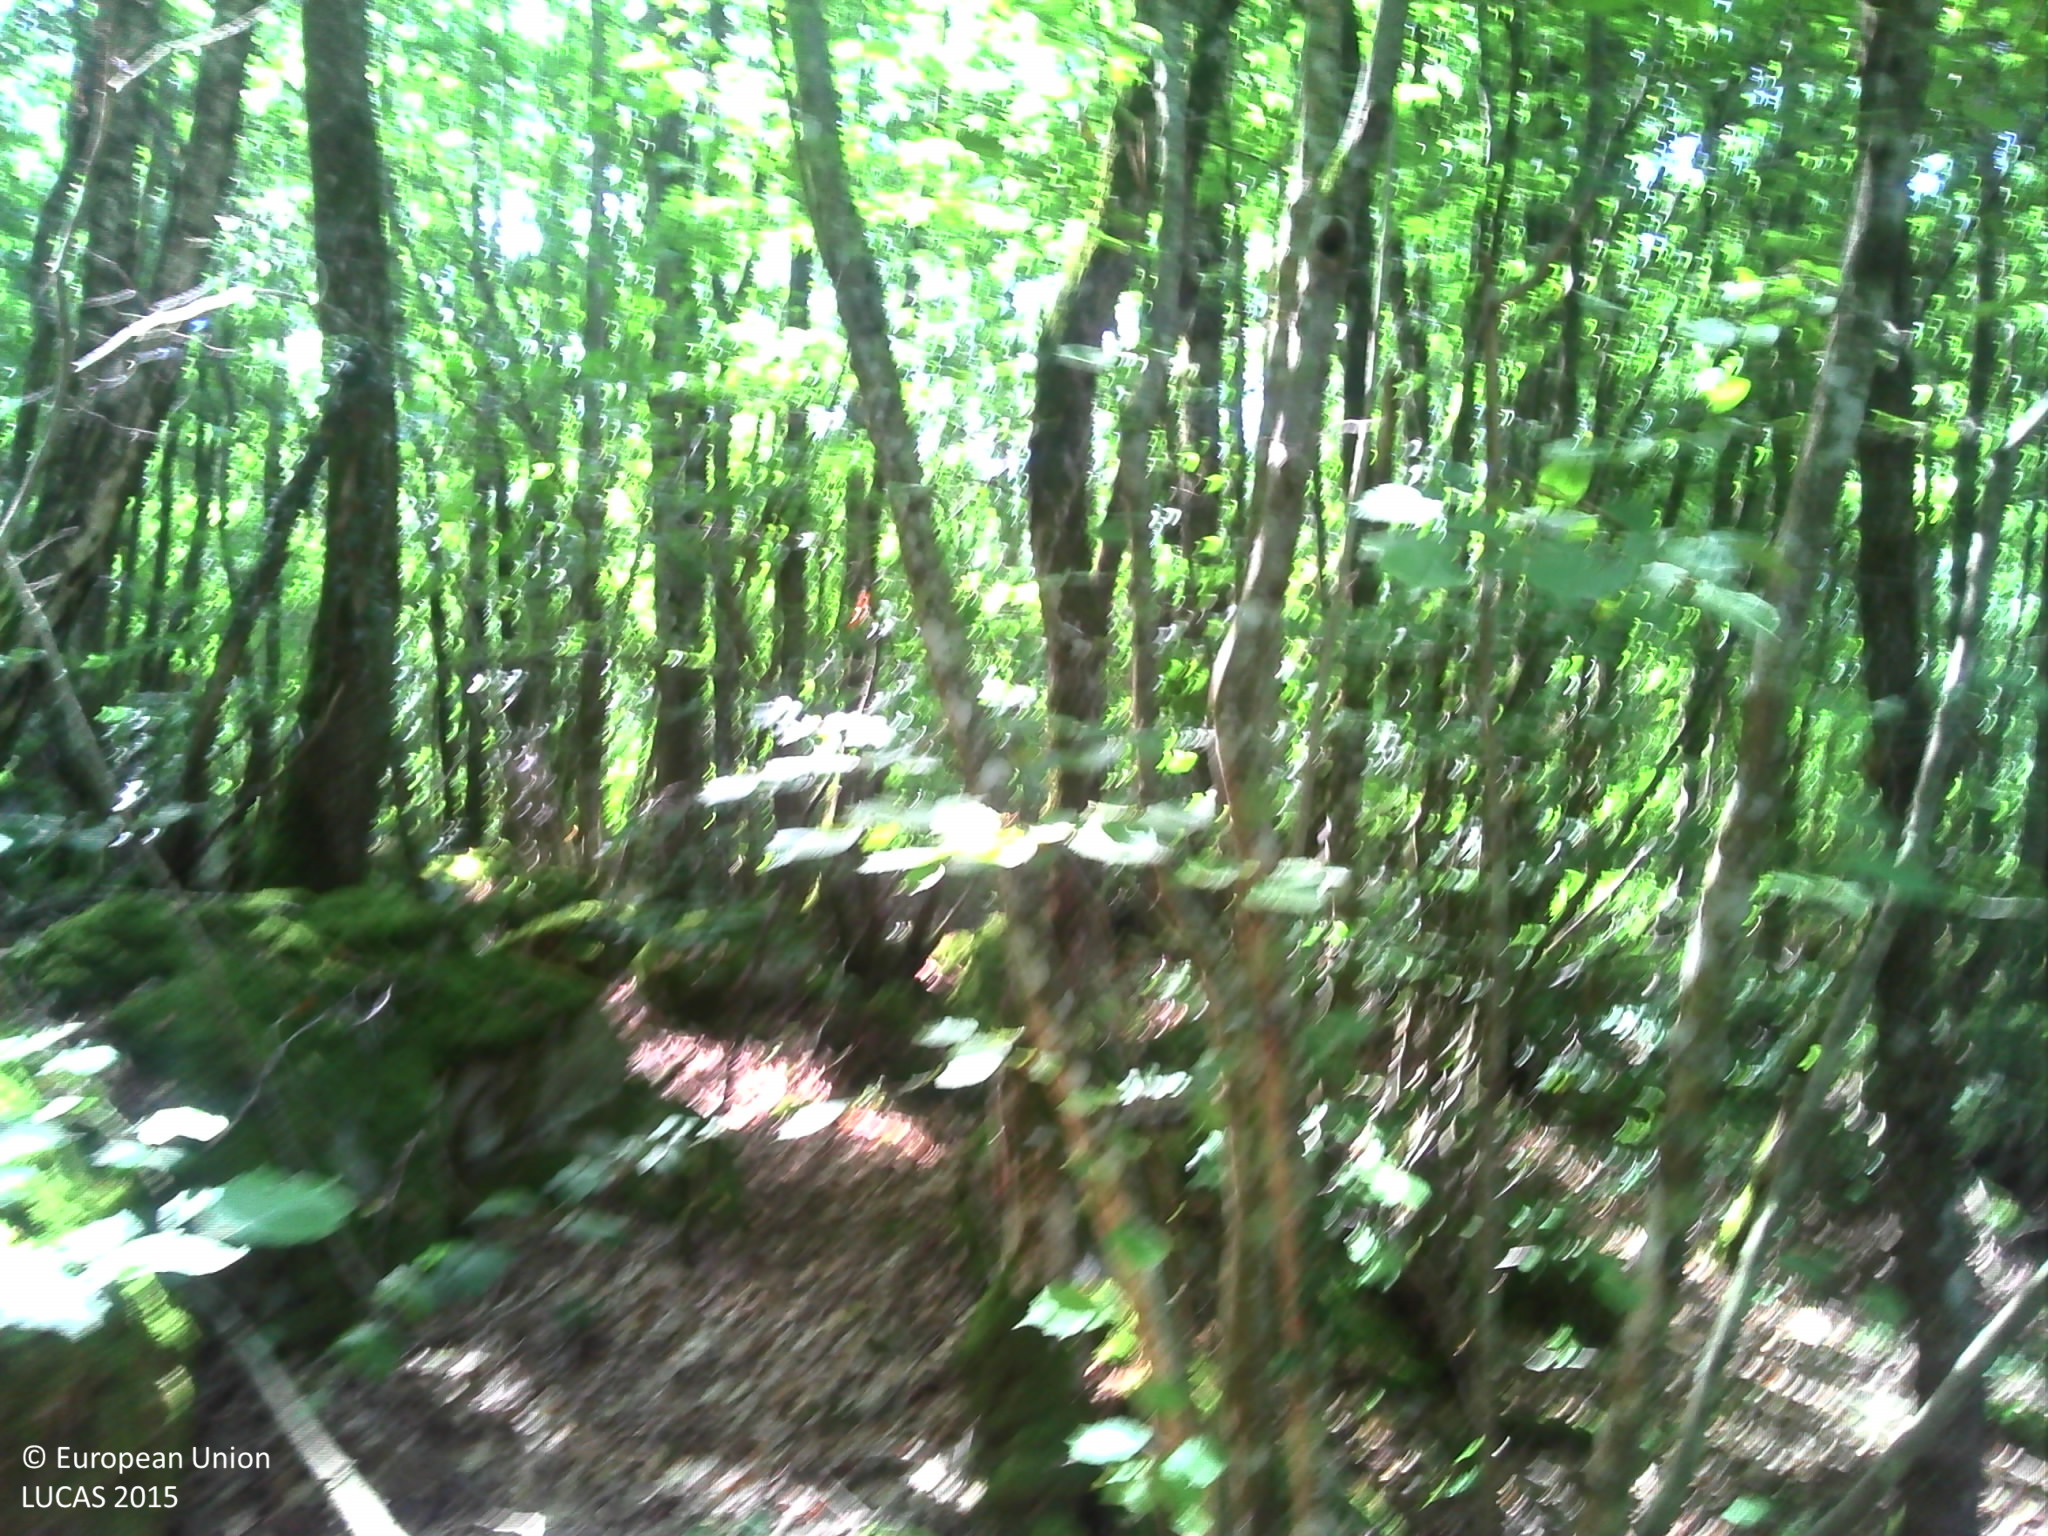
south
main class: Woodland
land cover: Broadleaved woodland
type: acidophilous oak and oak-birch forest
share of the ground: > 75 %
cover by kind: broadleaved forest trees 65 %, shrubs 10 %, herbaceous plants 10 %, consolidated bare surface 10 %, lichens and mosses 5 %
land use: Forestry
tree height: > 5 m
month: August
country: FR
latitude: 45.9501
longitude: 2.3460
